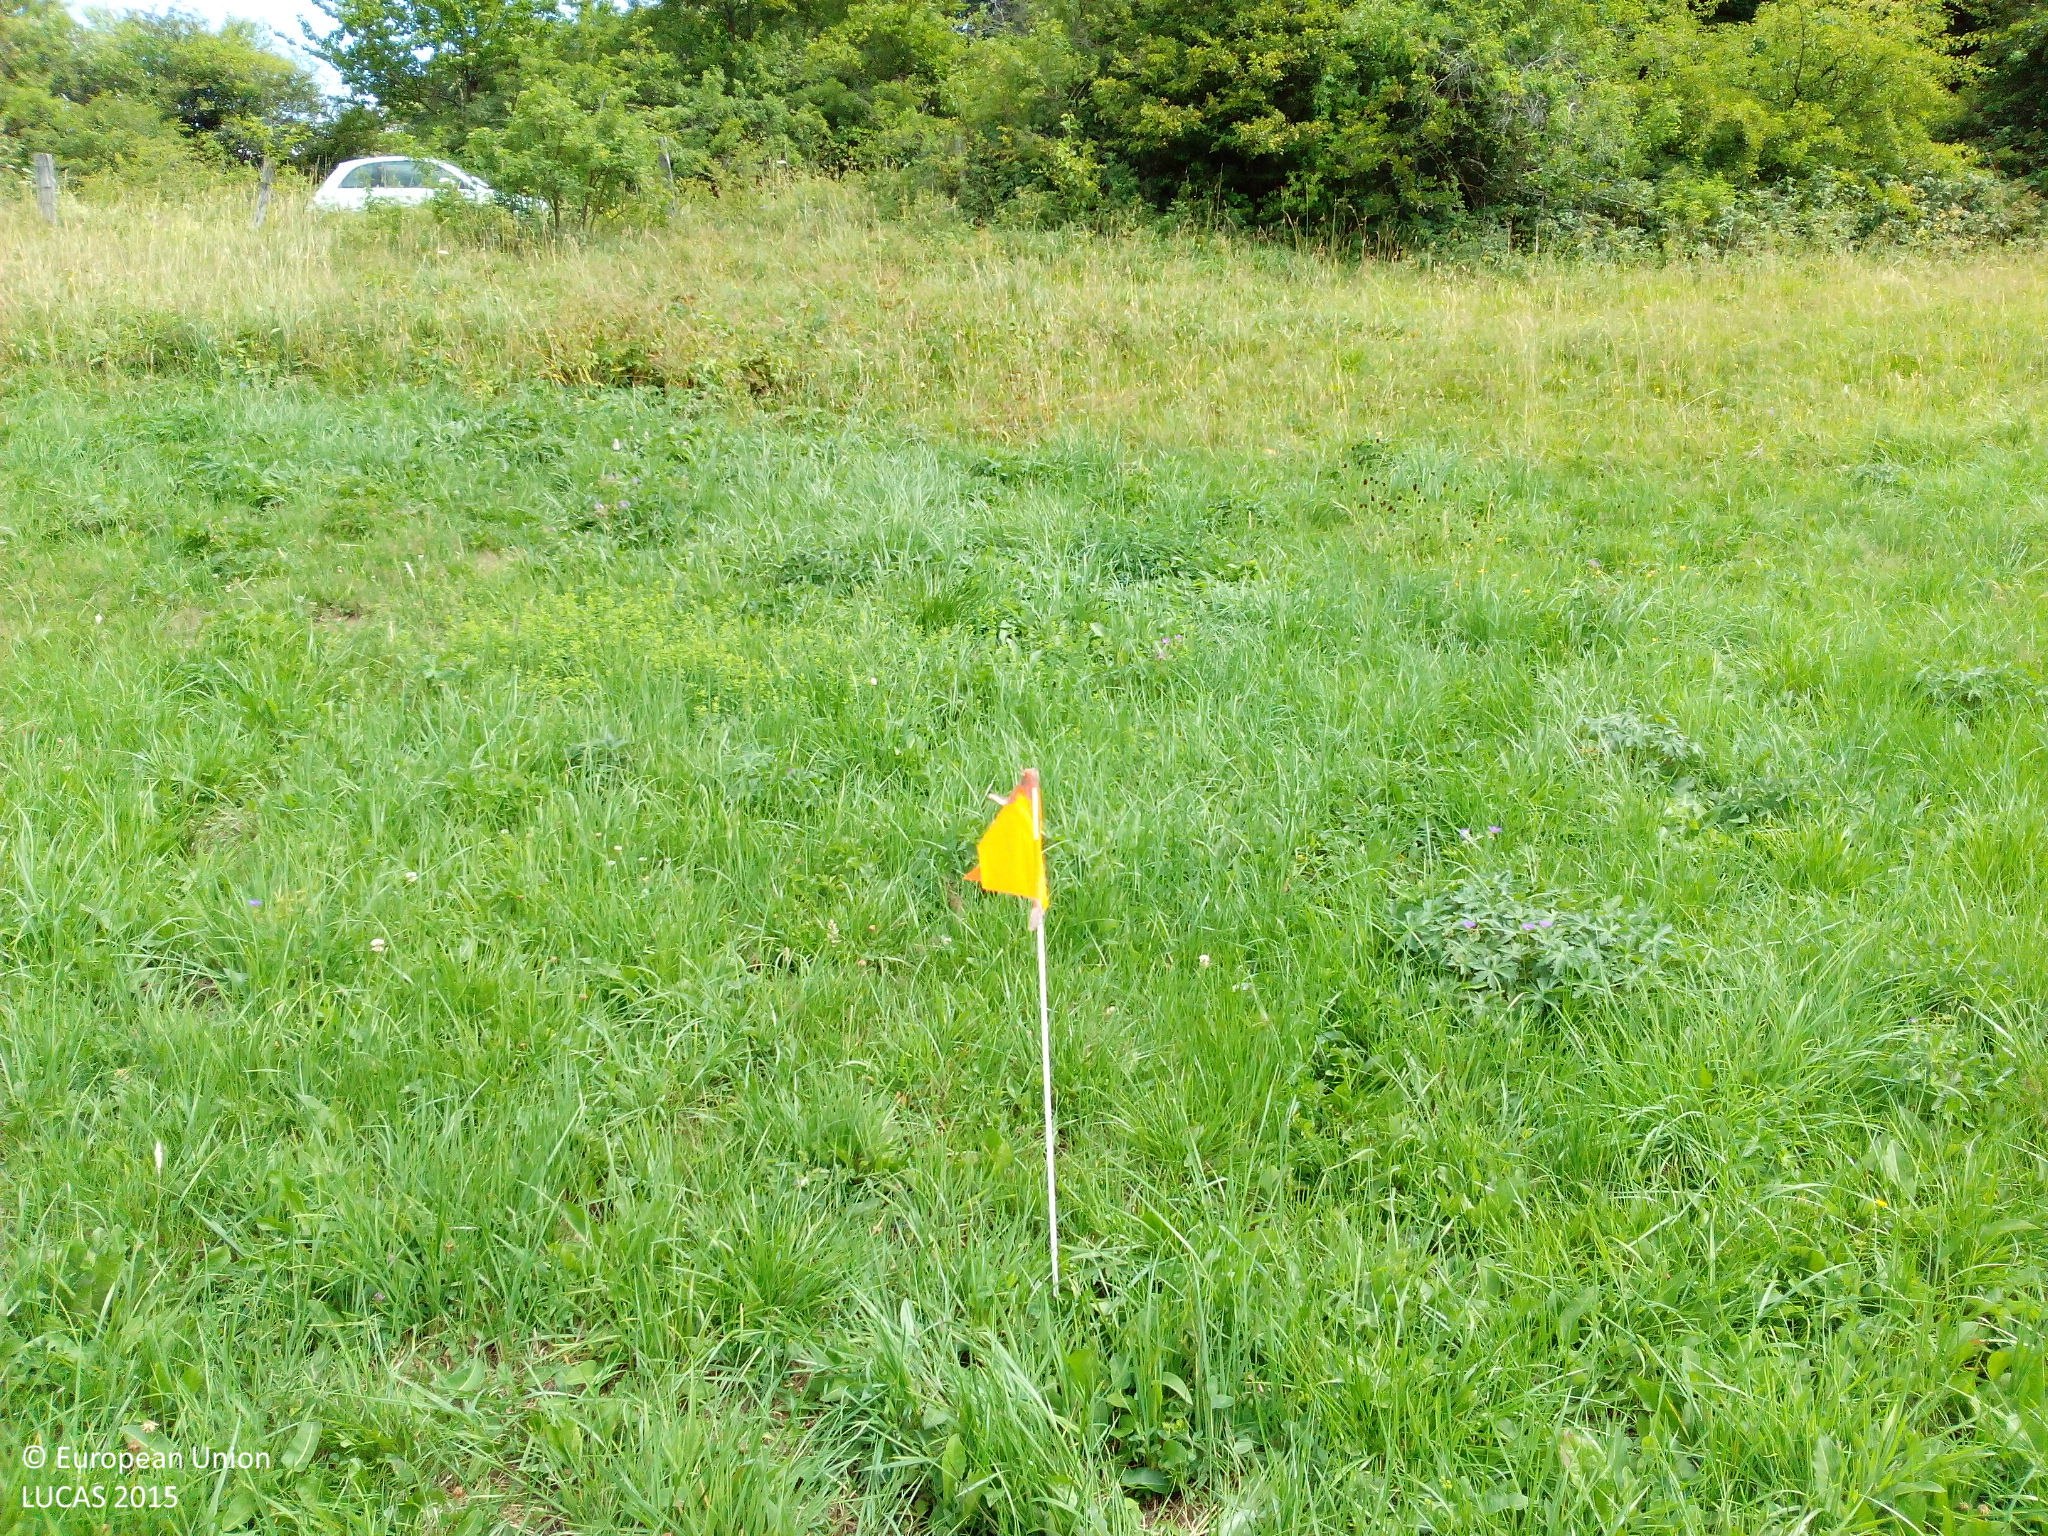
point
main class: Grassland
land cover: Grassland without tree/shrub cover
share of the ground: > 75 %
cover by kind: herbaceous plants 100 %
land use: Agriculture (excluding fallow land and kitchen gardens)
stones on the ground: < 10 %
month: July
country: DE
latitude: 50.4360
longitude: 9.9578
